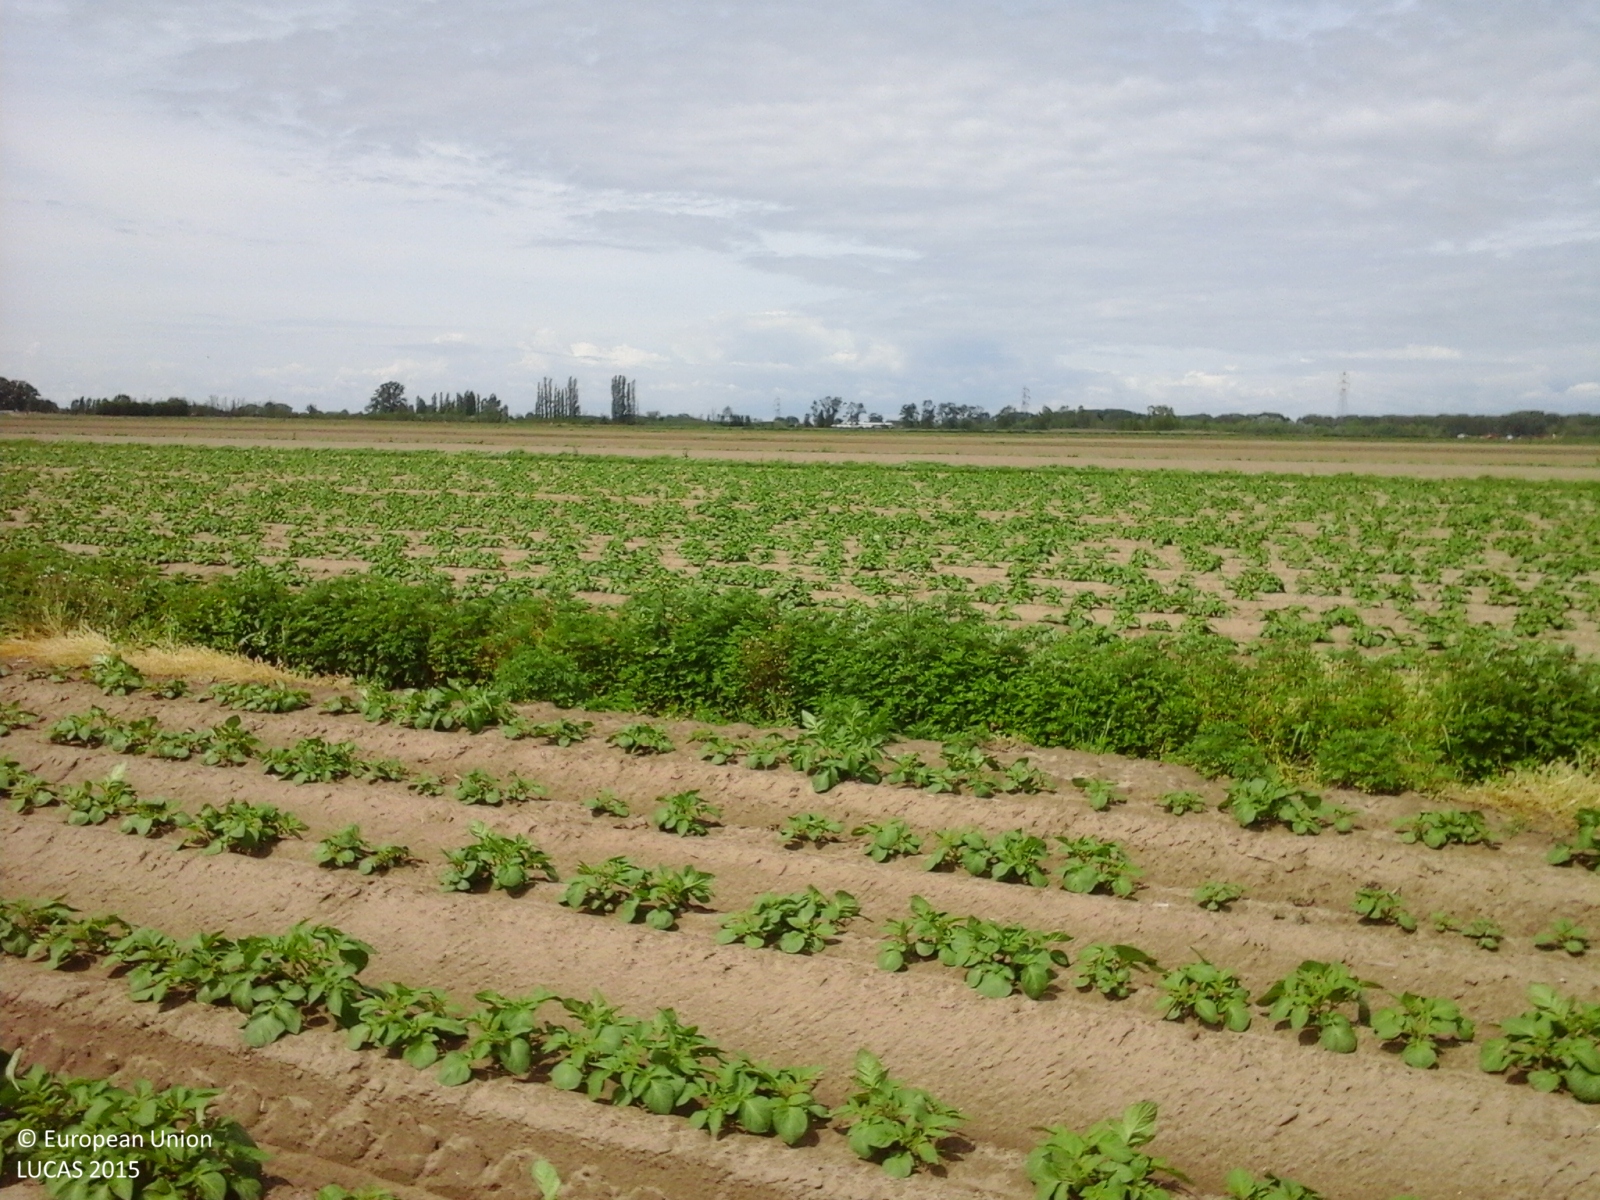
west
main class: Cropland
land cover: Potatoes
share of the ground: 25 - 50 %
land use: Agriculture (excluding fallow land and kitchen gardens)
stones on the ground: < 10 %
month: April
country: IT
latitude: 44.8867
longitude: 12.1862
